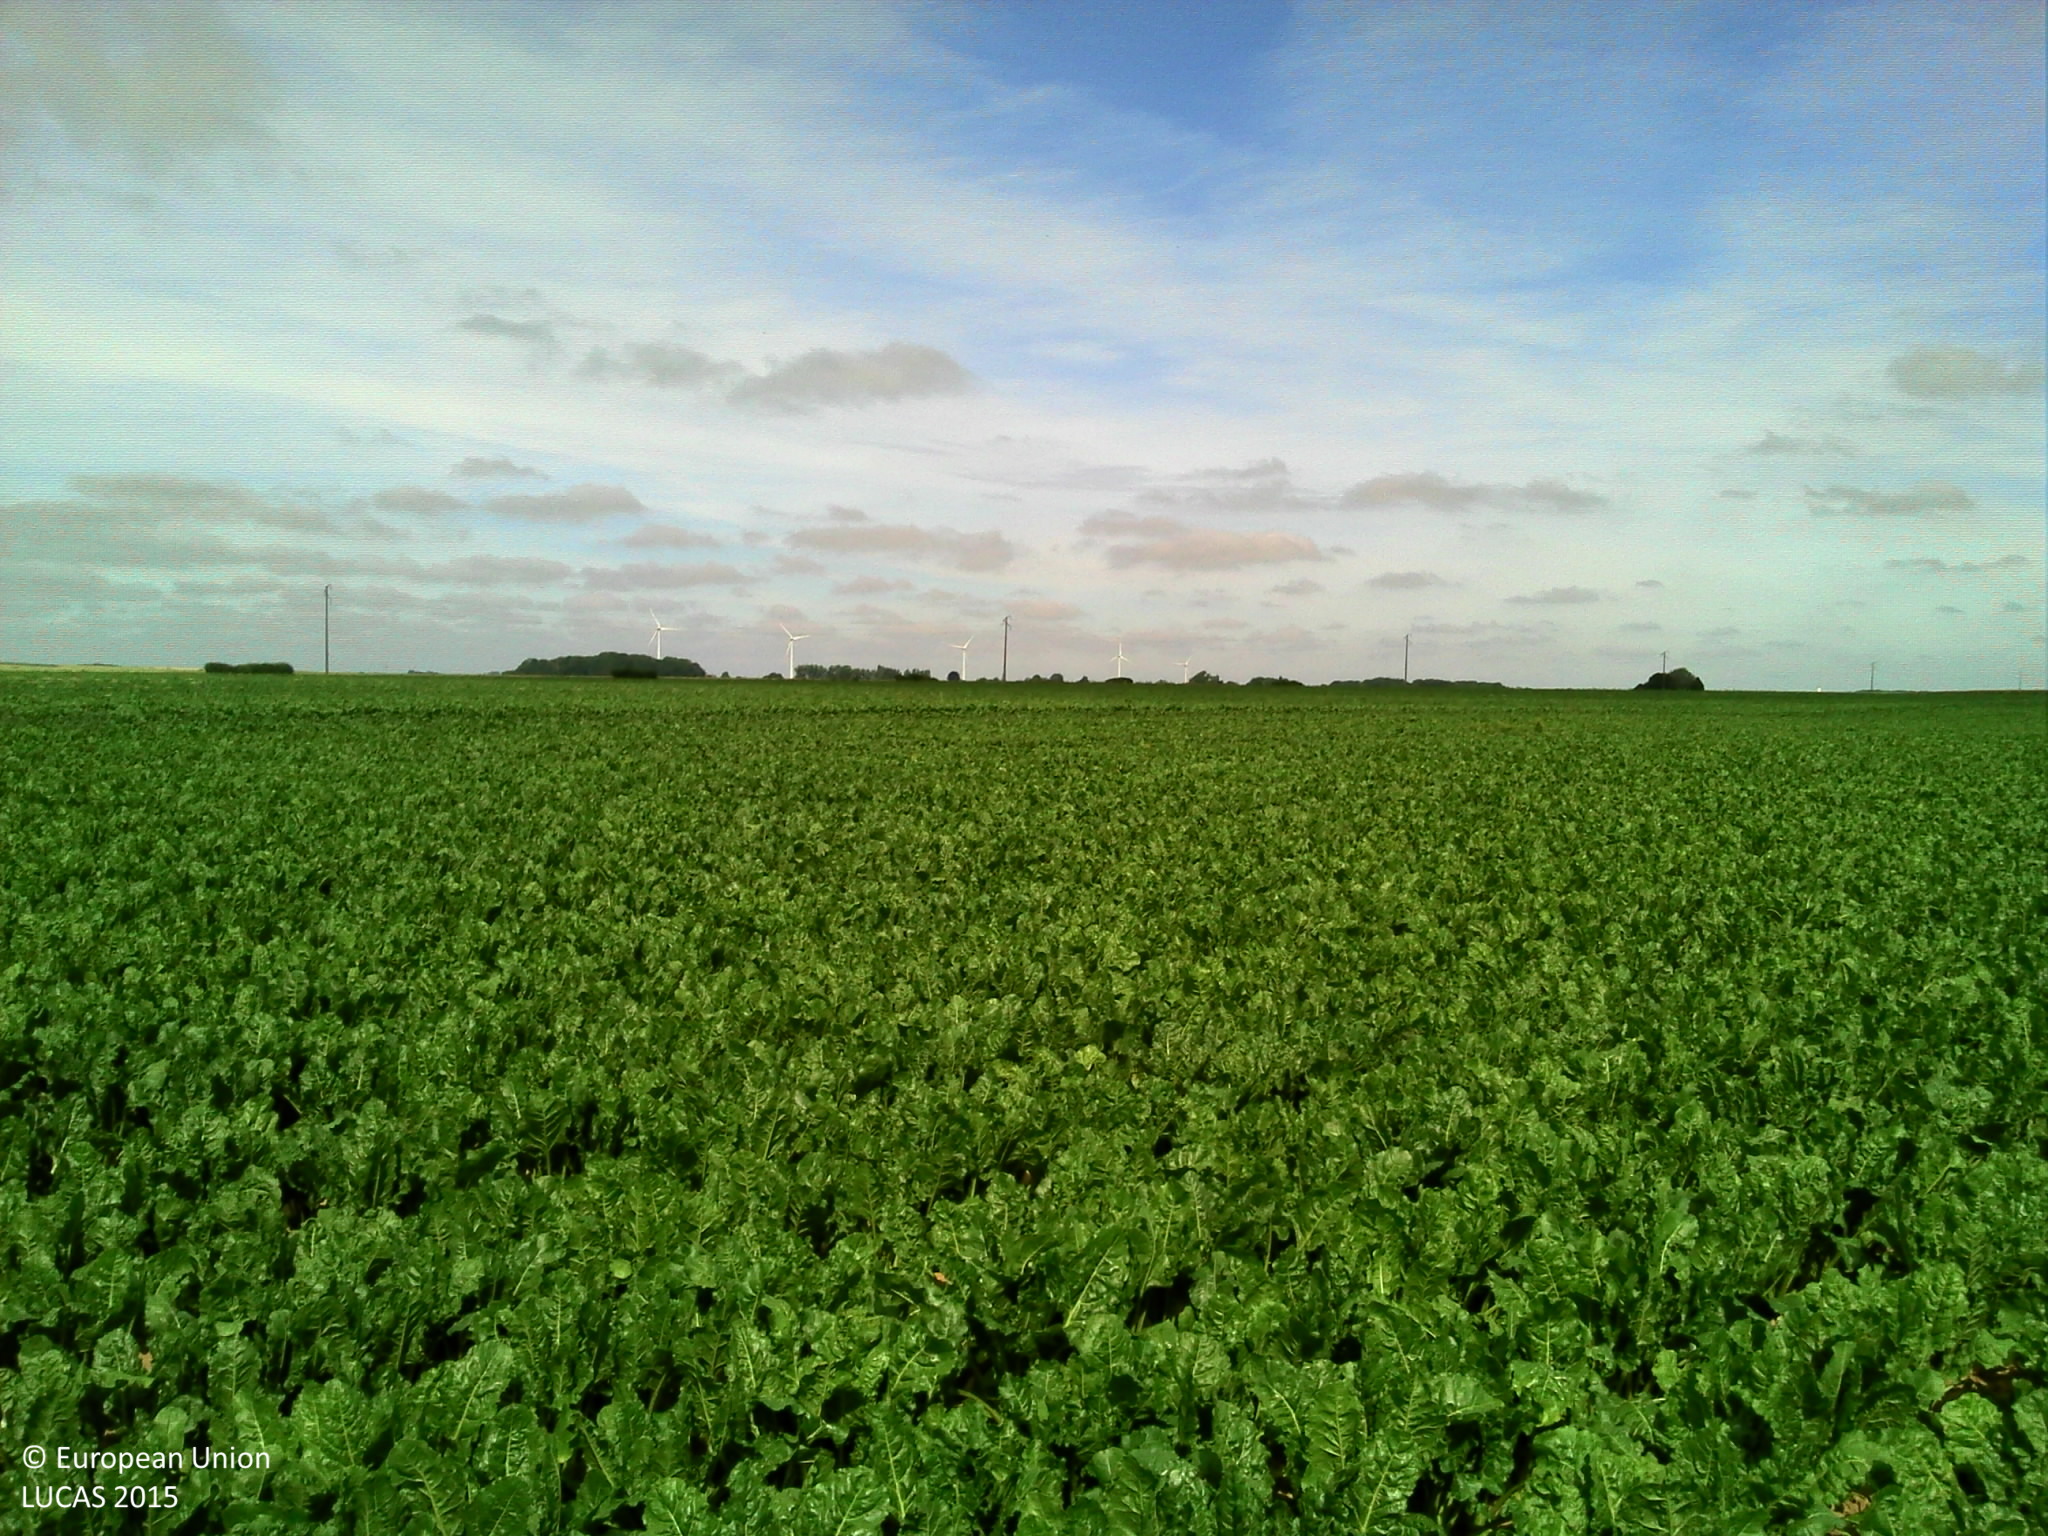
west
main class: Cropland
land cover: Sugar beet
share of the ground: > 75 %
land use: Agriculture (excluding fallow land and kitchen gardens)
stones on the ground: < 10 %
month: June
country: FR
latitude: 49.5651
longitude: 2.3410
